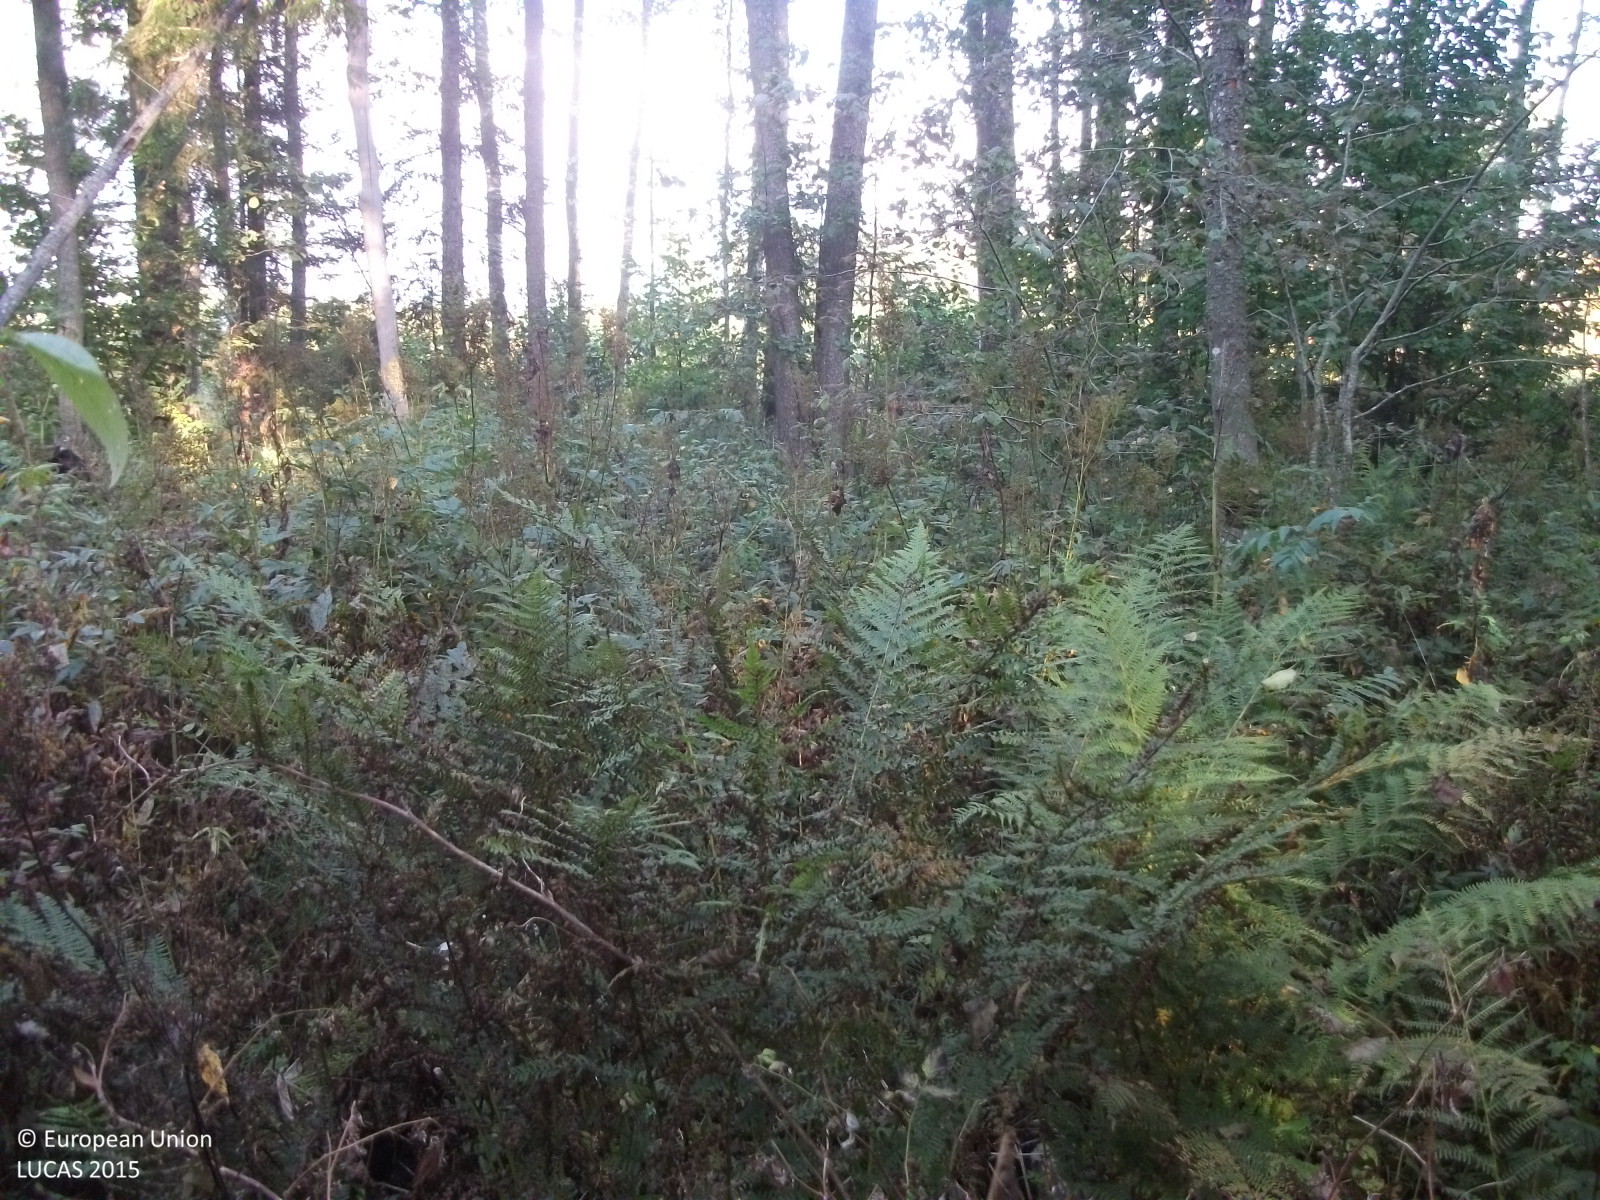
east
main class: Woodland
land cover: Broadleaved woodland
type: mire and swamp forests
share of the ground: > 75 %
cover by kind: broadleaved forest trees 80 %, herbaceous plants 10 %, shrubs 5 %, lichens and mosses 5 %
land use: Forestry
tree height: > 5 m
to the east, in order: Broadleaved woodland; Shrubland with sparse tree cover; Spruce dominated coniferous woodland
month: September
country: LV
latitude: 57.8199
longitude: 24.7582
